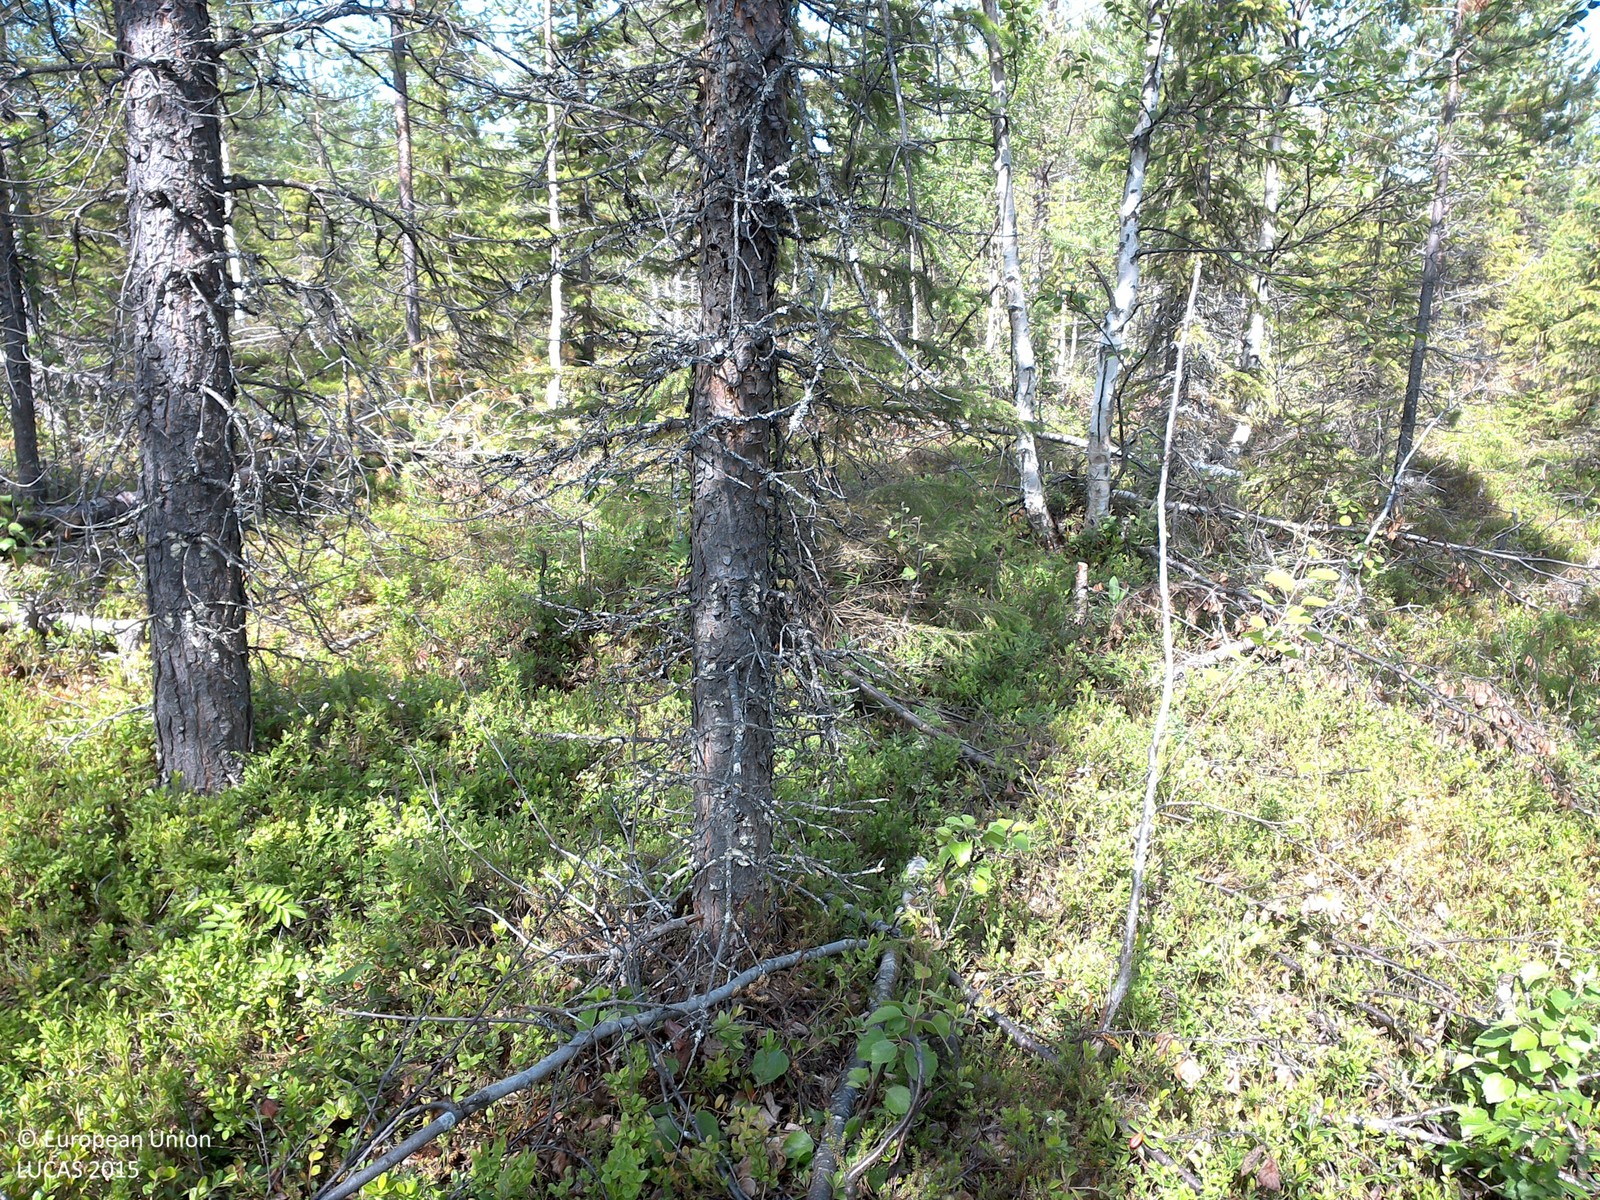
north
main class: Woodland
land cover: Pine dominated mixed woodland
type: boreal forest
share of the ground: 10 - 25 %
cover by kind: shrubs 65 %, coniferous forest trees 20 %, broadleaved forest trees 10 %, lichens and mosses 5 %
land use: Forestry
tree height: > 5 m
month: July
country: SE
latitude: 67.1091
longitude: 23.0783
